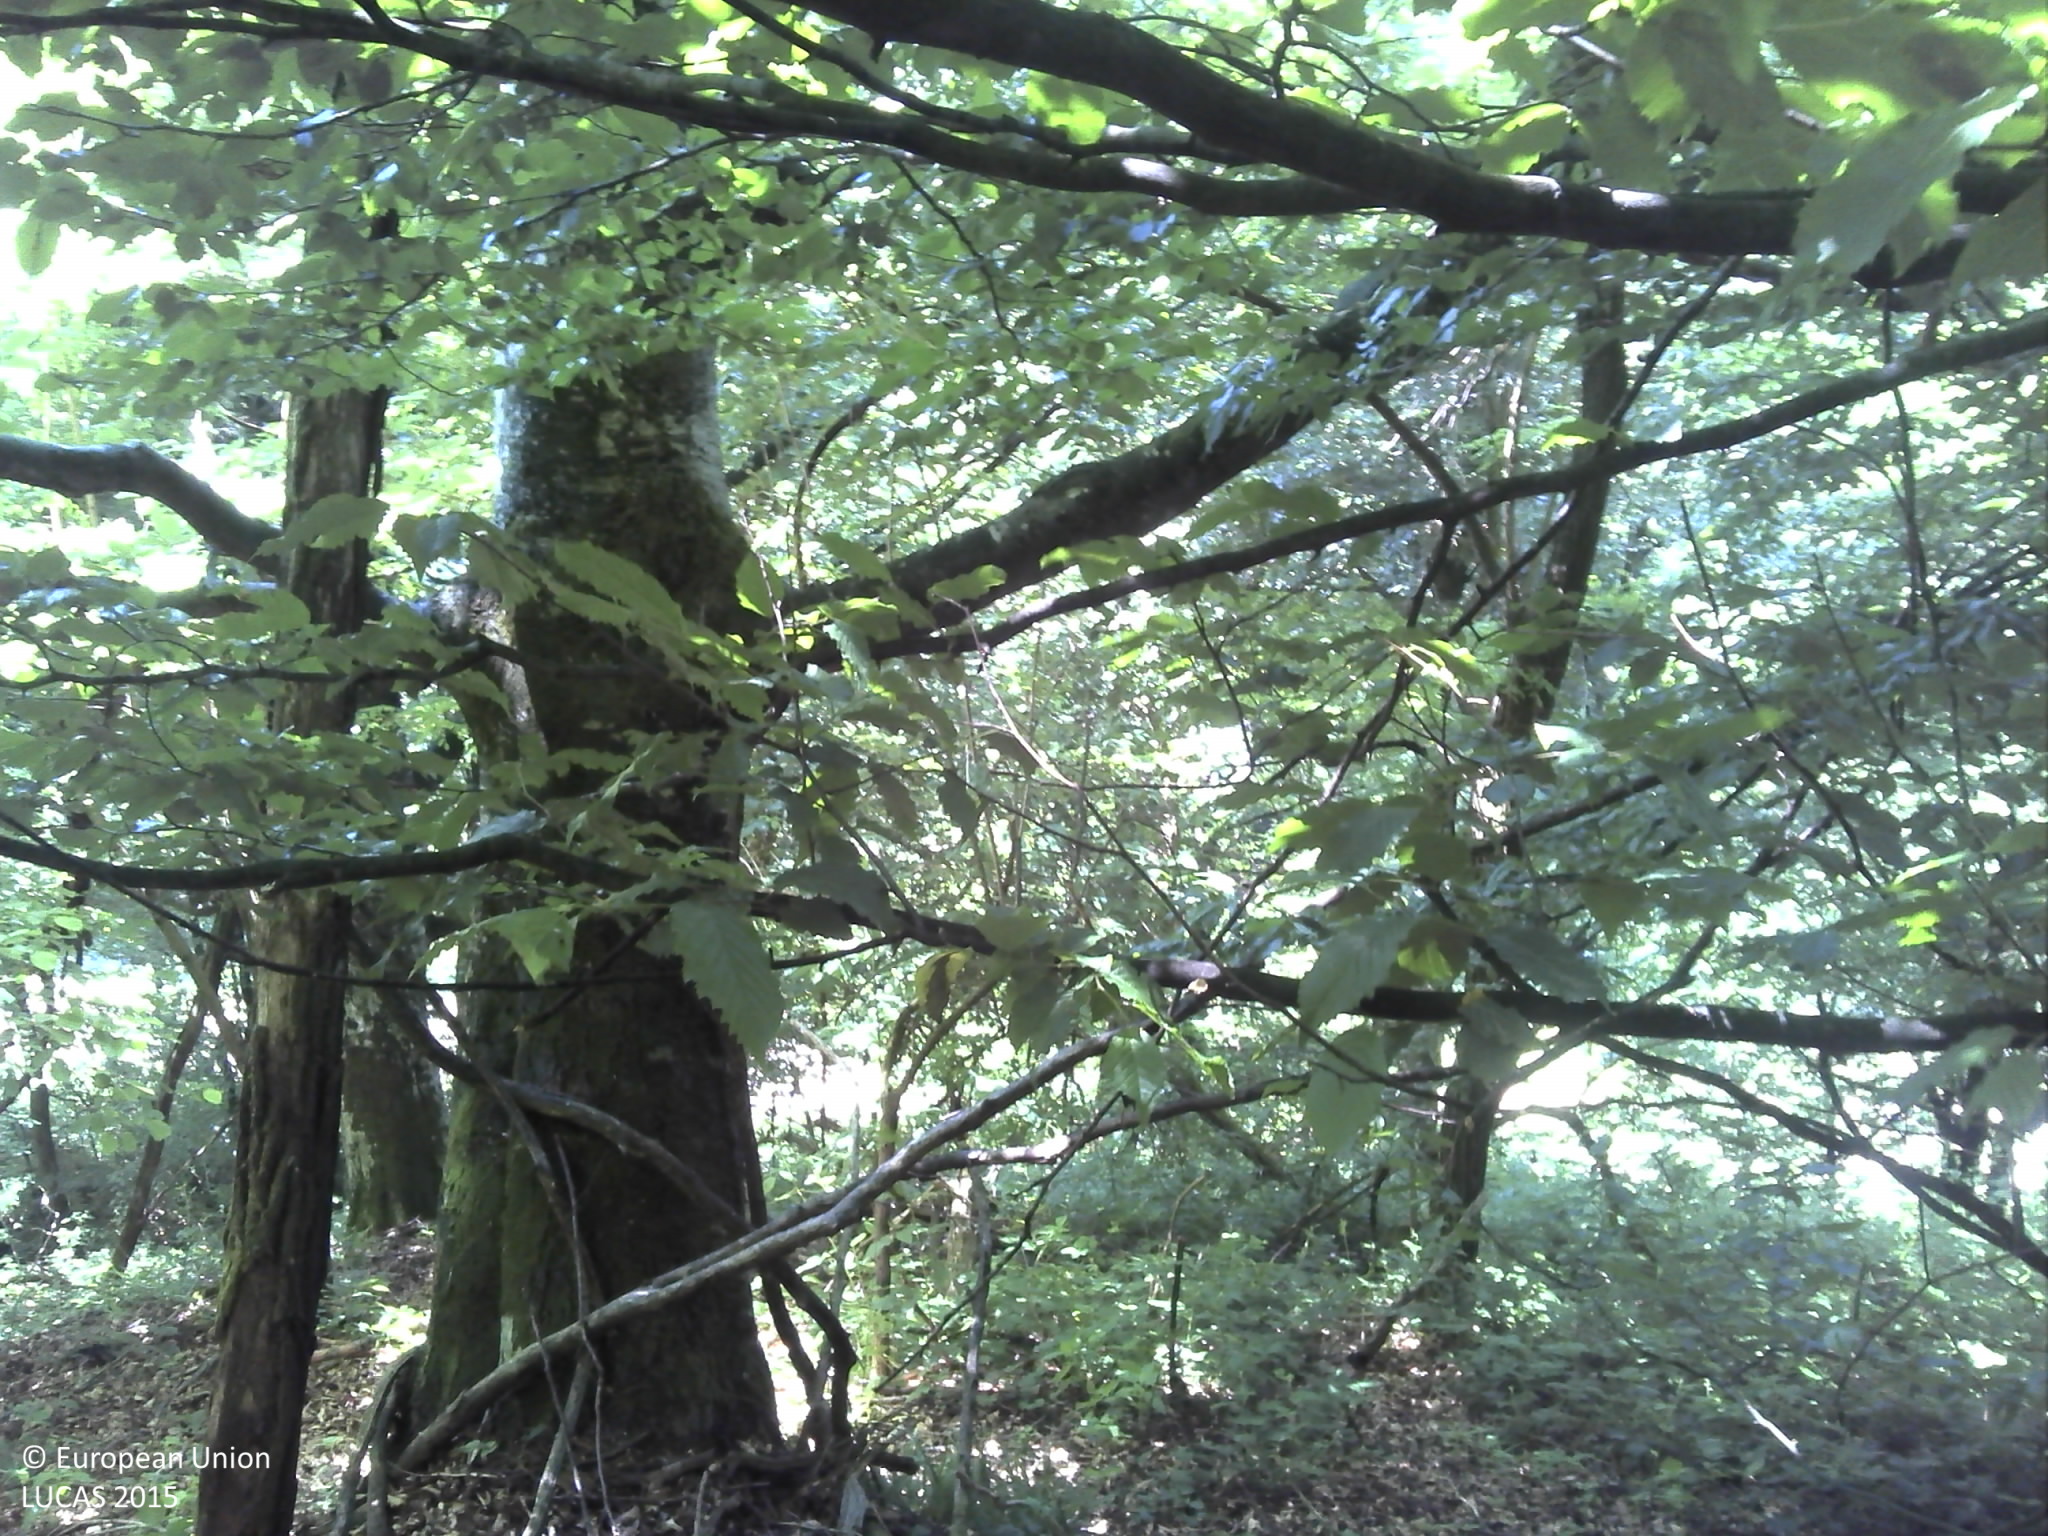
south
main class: Woodland
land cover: Broadleaved woodland
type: acidophilous oak and oak-birch forest
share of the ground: > 75 %
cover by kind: broadleaved forest trees 80 %, lichens and mosses 20 %
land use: Forestry
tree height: > 5 m
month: June
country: HR
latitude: 45.4676
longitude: 17.8176
